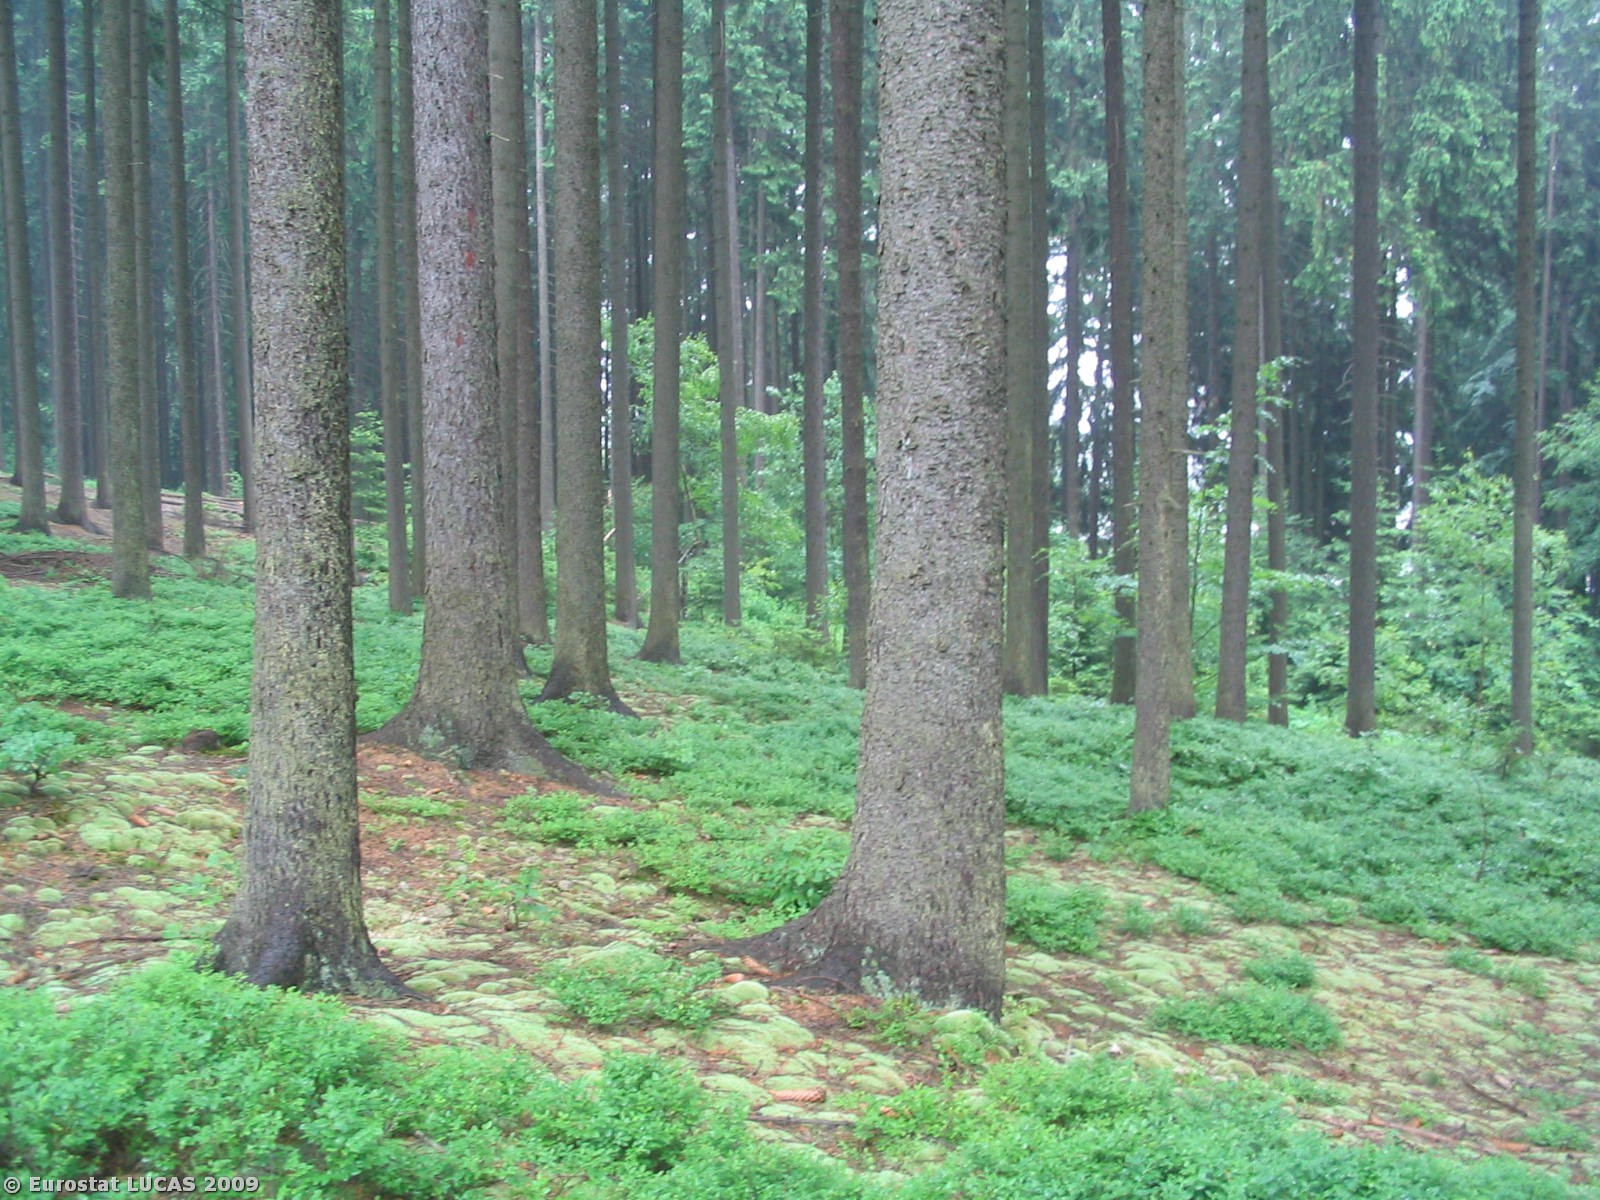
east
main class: Woodland
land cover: Coniferous woodland
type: hemiboreal forest and nemoral coniferous forest and mixed broadleaved-coniferous forest
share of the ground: > 75 %
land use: Forestry
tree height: > 5 m
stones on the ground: < 10 %
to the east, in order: Coniferous woodland; Tracks; Coniferous woodland; Fences; Artificial constructions in urban areas
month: June
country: CZ
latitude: 49.5049
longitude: 18.7339
